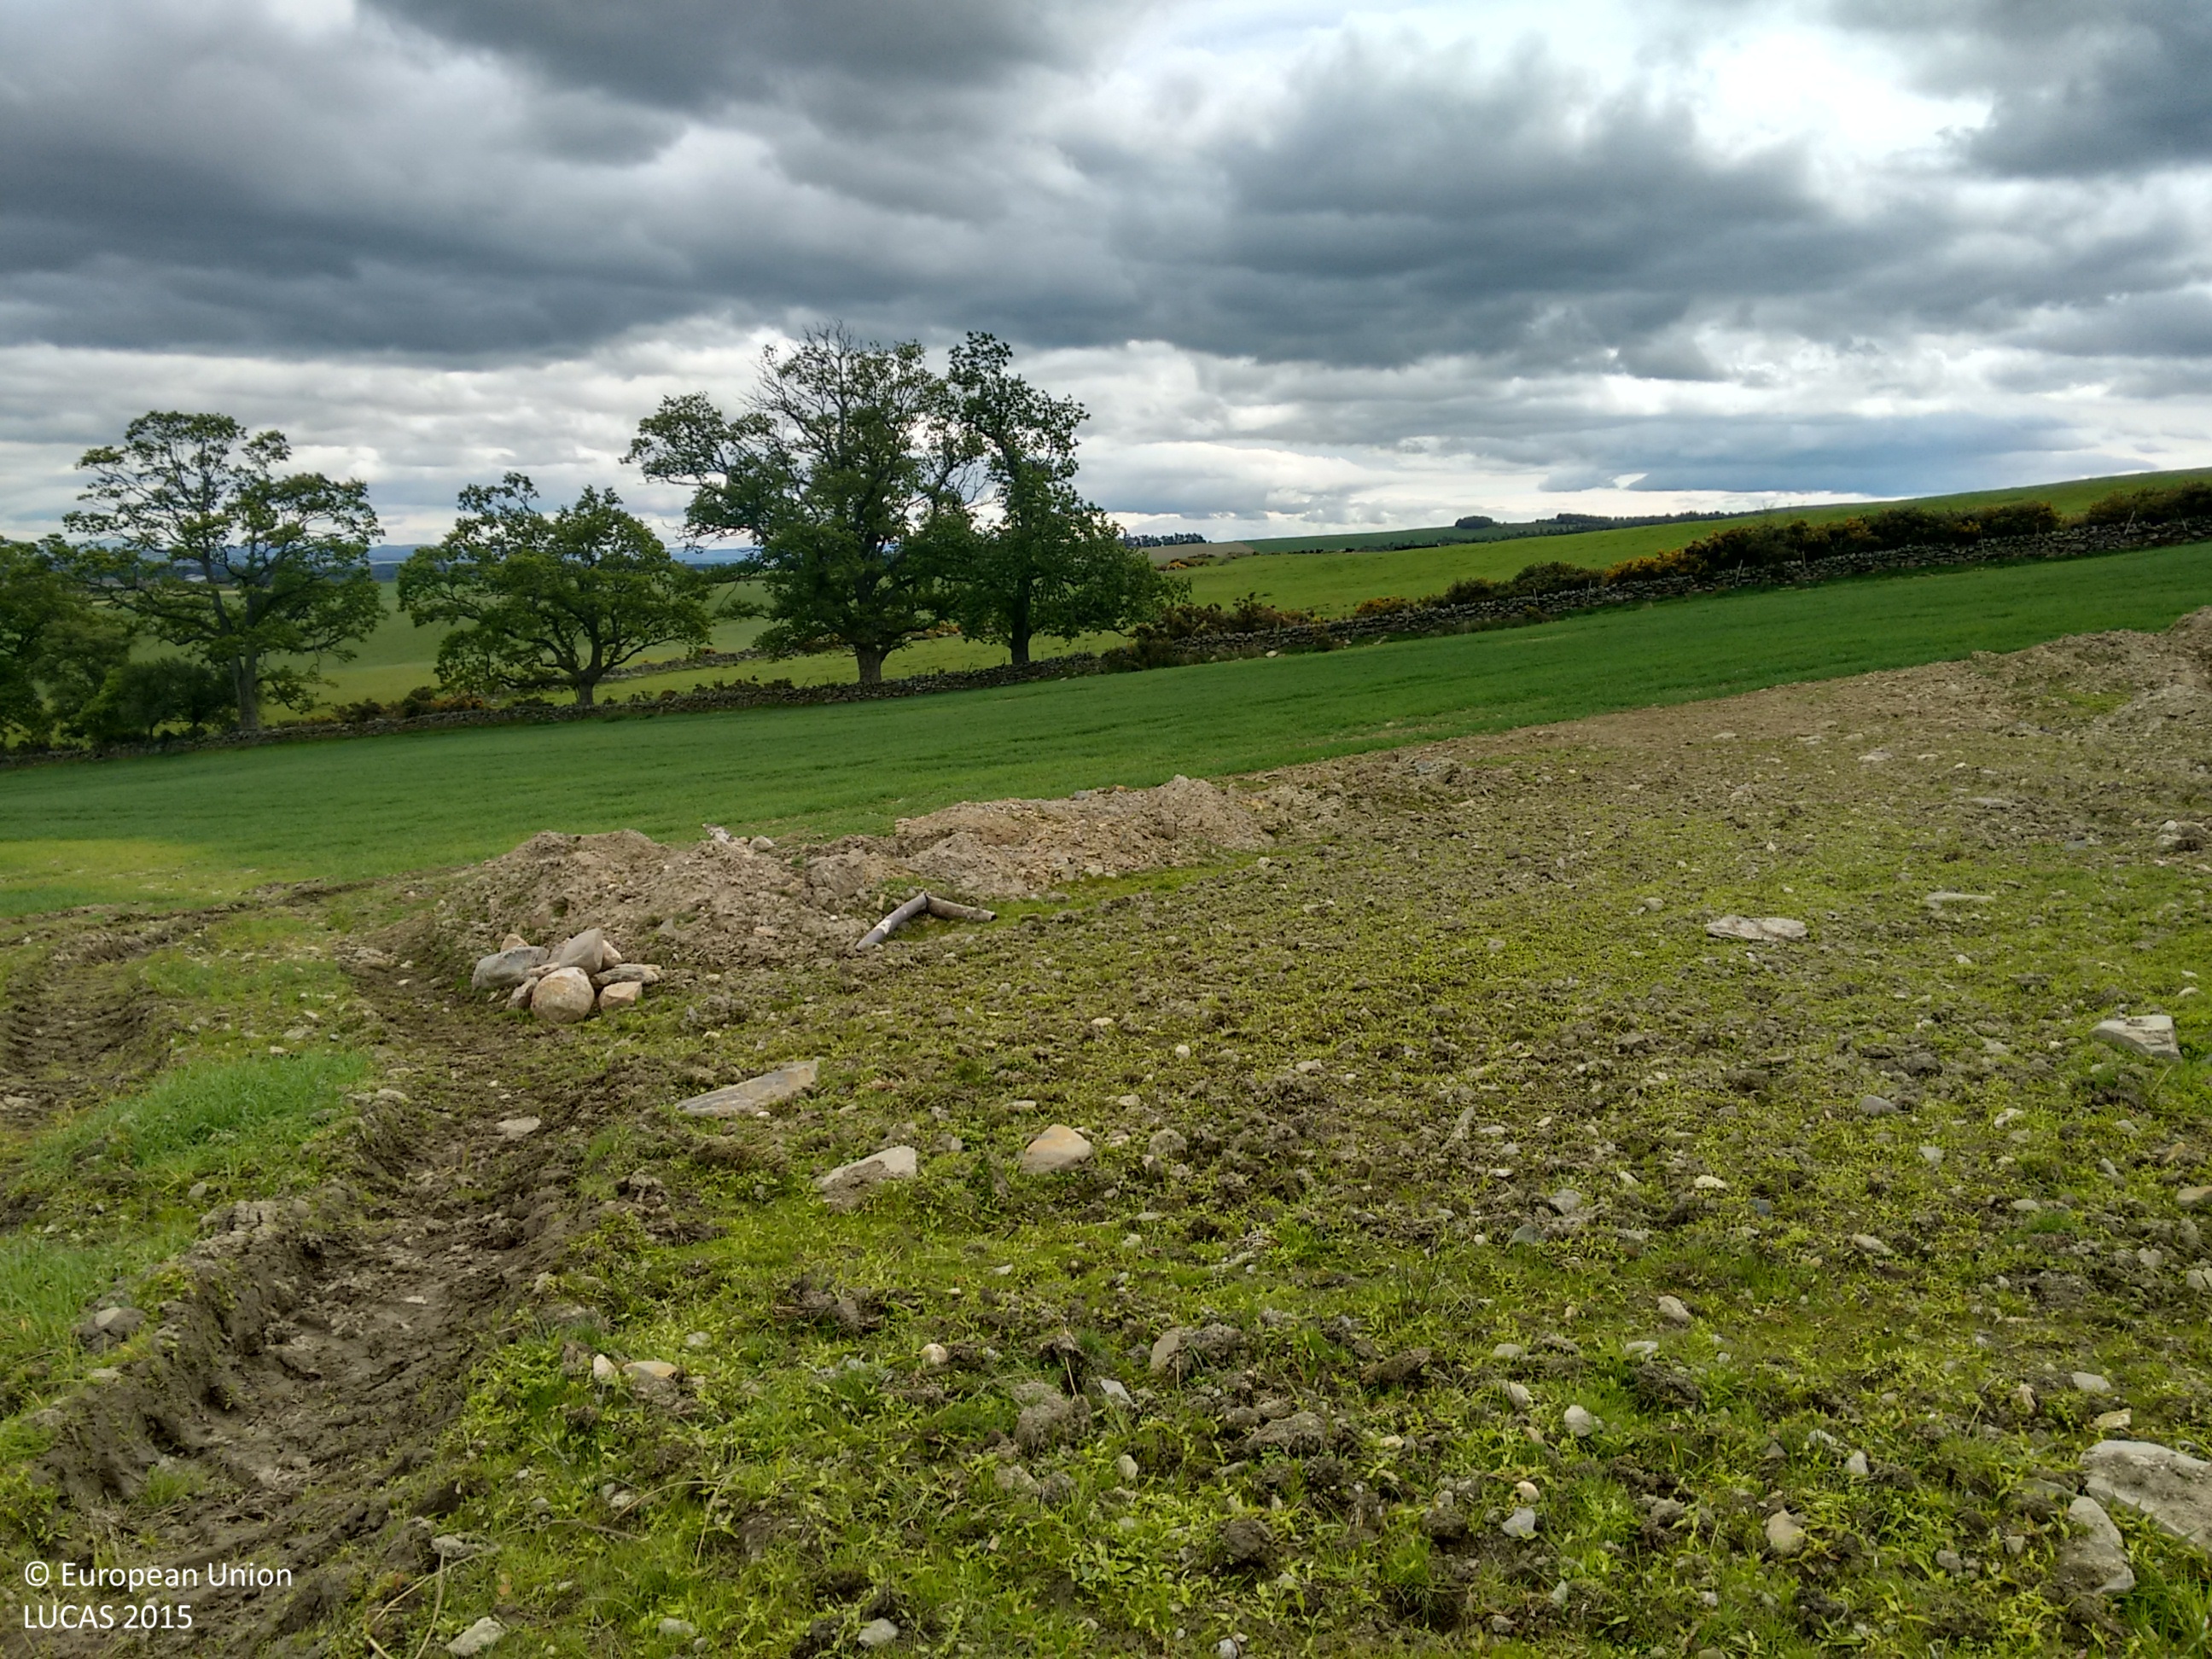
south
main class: Grassland
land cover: Grassland without tree/shrub cover
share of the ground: > 75 %
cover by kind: unconsolidated bare surface 70 %, herbaceous plants 30 %
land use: Agriculture (excluding fallow land and kitchen gardens)
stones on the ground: 25 - 50 %
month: June
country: GB
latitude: 56.5203
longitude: -3.5837
